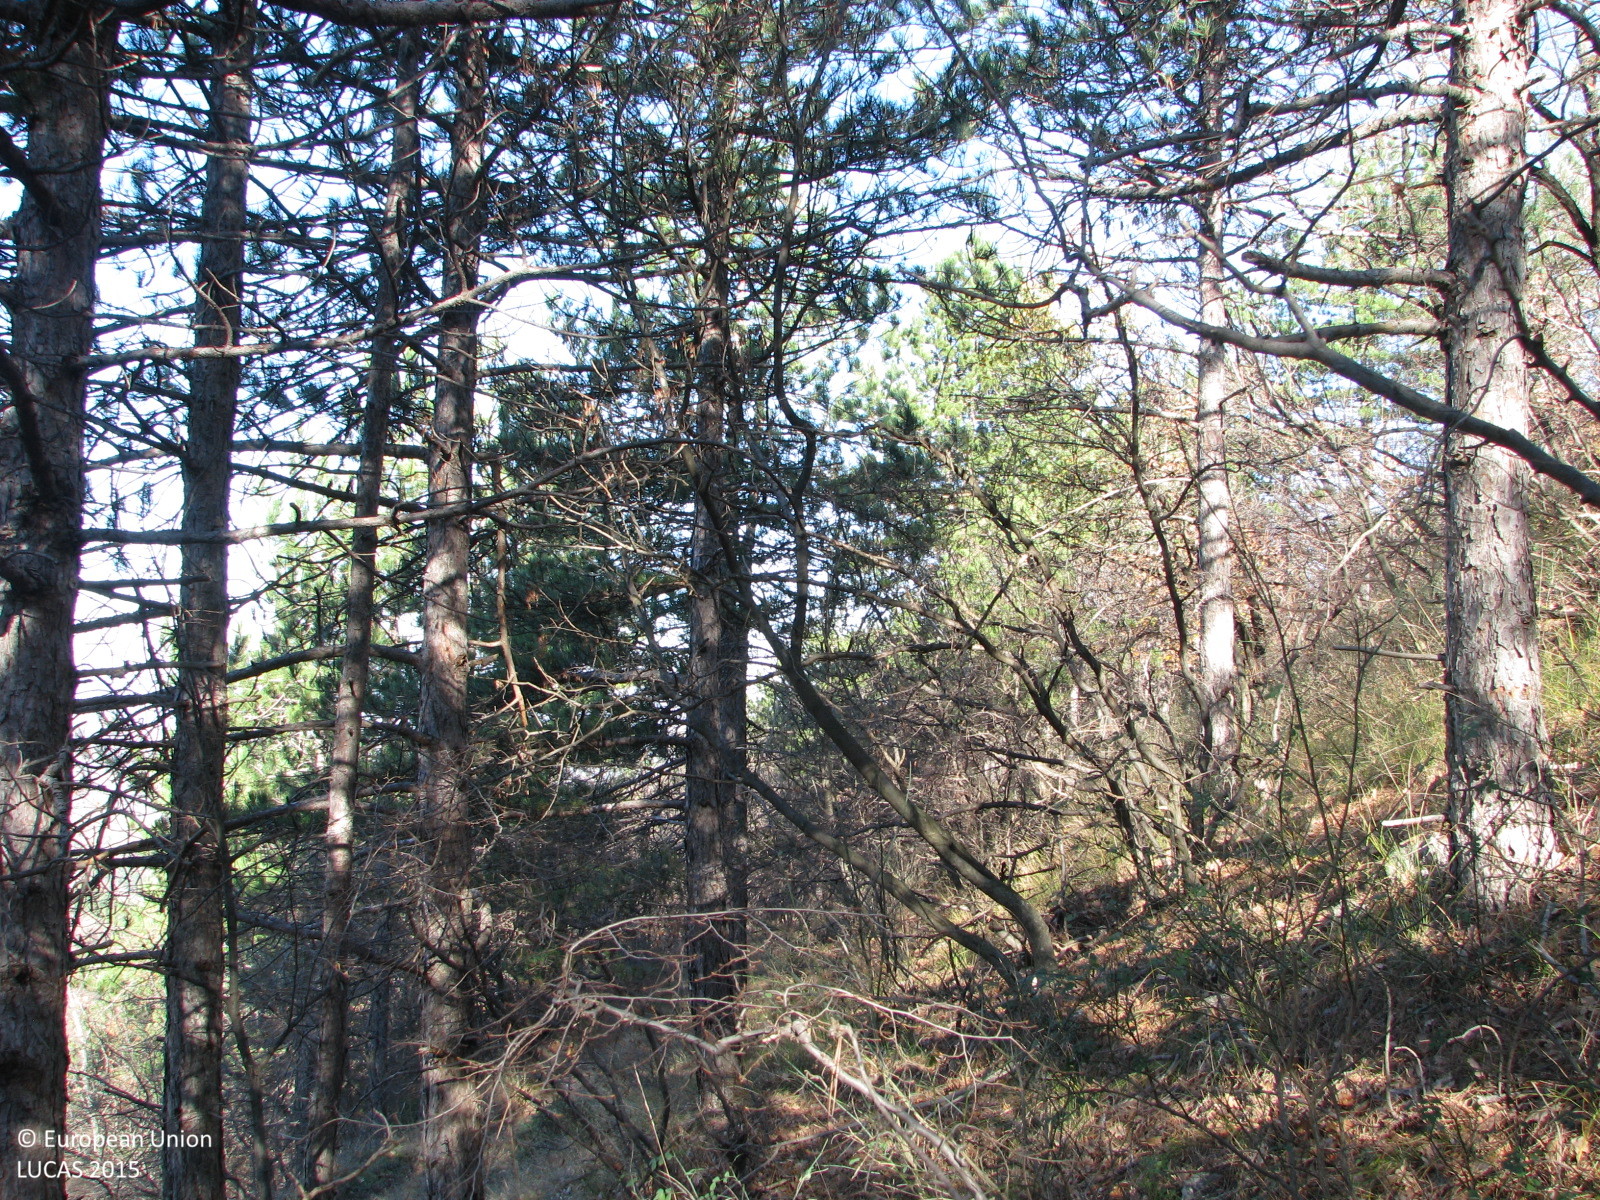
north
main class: Woodland
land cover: Pine dominated mixed woodland
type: hemiboreal forest and nemoral coniferous forest and mixed broadleaved-coniferous forest
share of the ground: > 75 %
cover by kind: coniferous forest trees 40 %, broadleaved forest trees 40 %, herbaceous plants 10 %, shrubs 5 %, unconsolidated bare surface 5 %
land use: Forestry
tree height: > 5 m
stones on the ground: < 10 %
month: December
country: BG
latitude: 42.1052
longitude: 24.2022
